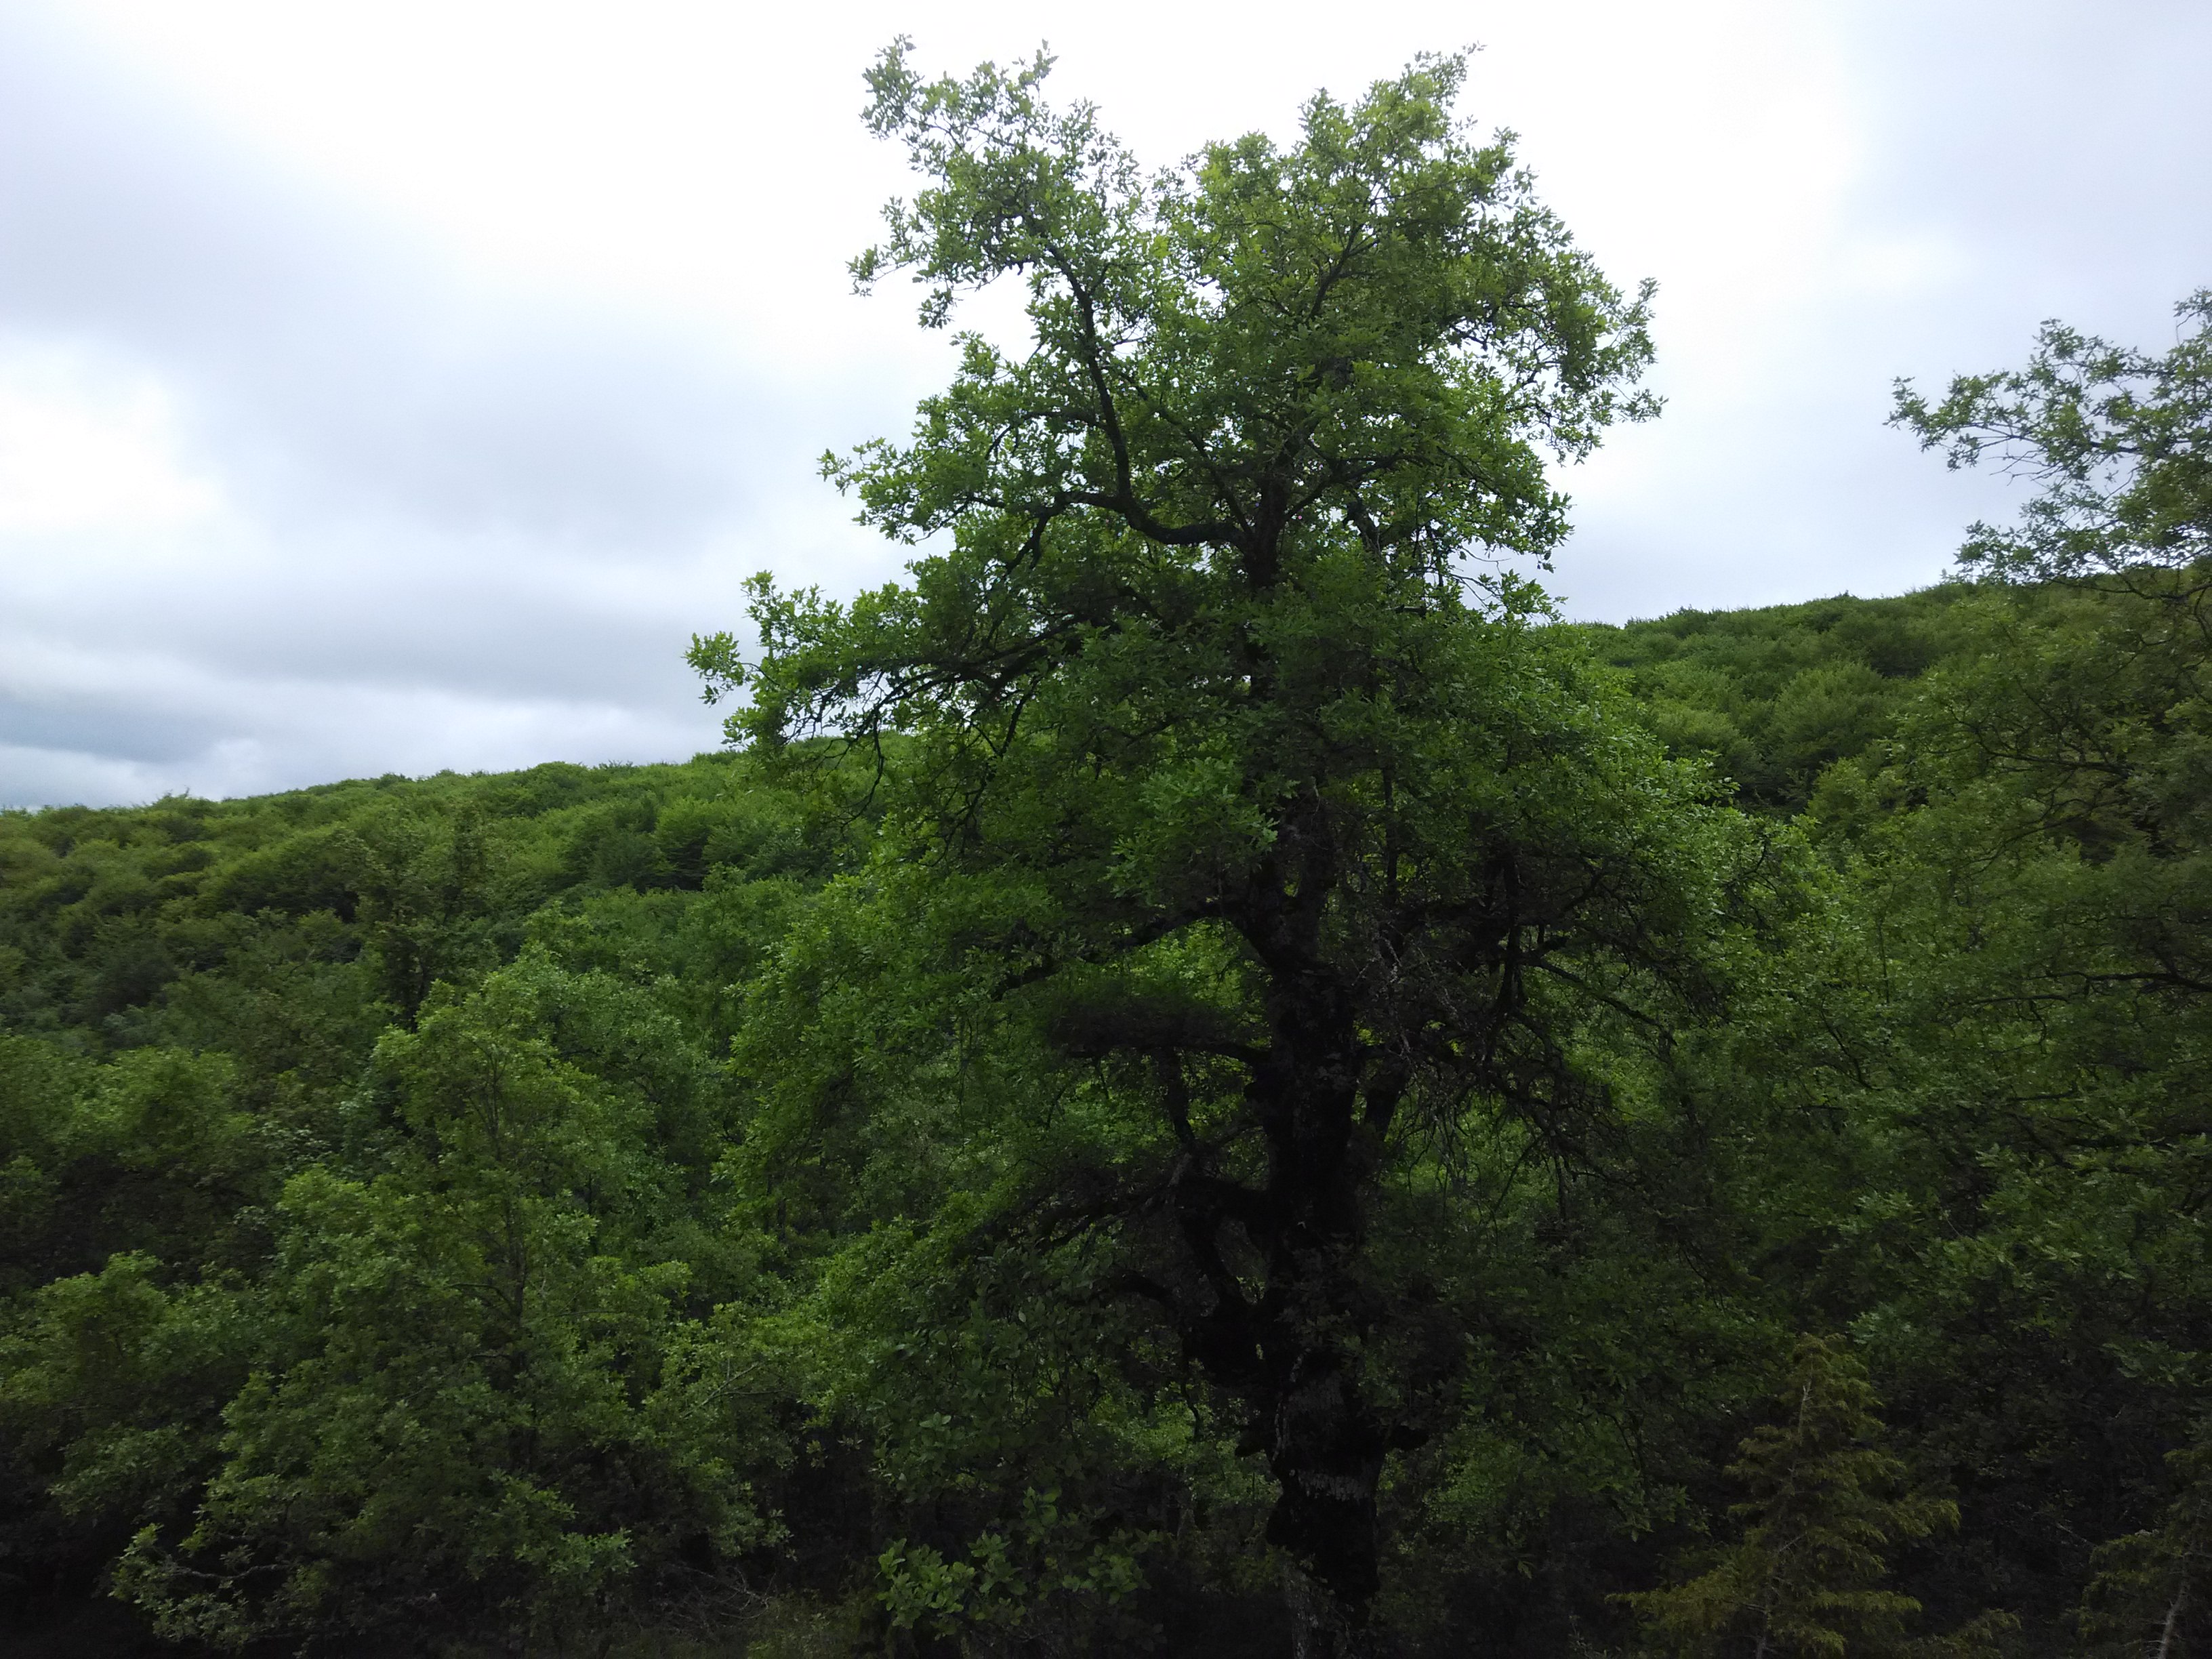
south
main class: Woodland
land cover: Broadleaved woodland
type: beech forest
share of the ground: > 75 %
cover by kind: broadleaved forest trees 85 %, coniferous forest trees 10 %, shrubs 5 %
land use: Forestry
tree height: > 5 m
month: May
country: ES
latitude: 42.7704
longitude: -2.5019
